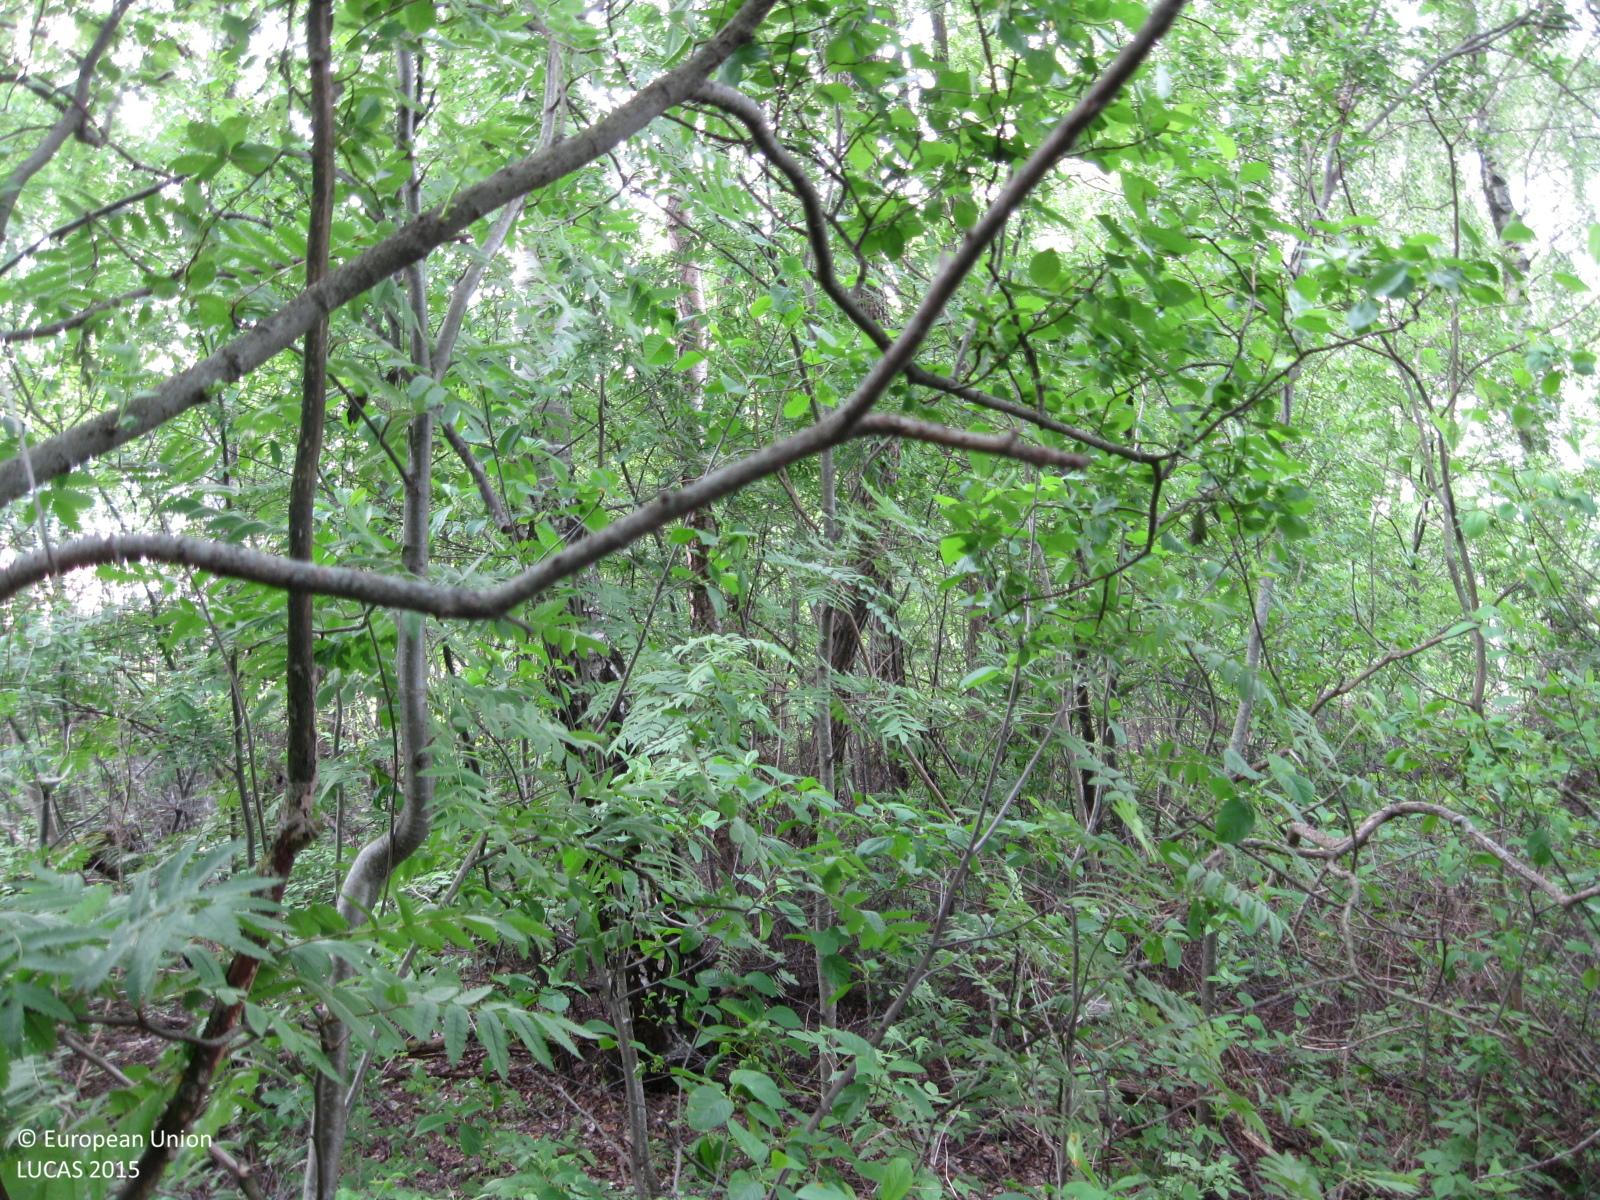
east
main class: Woodland
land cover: Broadleaved woodland
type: non-riverine alder, birch or aspen forest
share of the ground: > 75 %
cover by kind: broadleaved forest trees 75 %, shrubs 10 %, herbaceous plants 10 %, coniferous forest trees 5 %
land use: Semi-natural and natural areas not in use
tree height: > 5 m
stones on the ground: < 10 %
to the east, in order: Broadleaved woodland; Electric lines; Broadleaved woodland; Electric lines; Broadleaved woodland; Maize; Grass margins; Paved roads, cycling and walking lanes; Grass margins; Maize
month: June
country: LT
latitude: 55.7262
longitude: 23.6631
